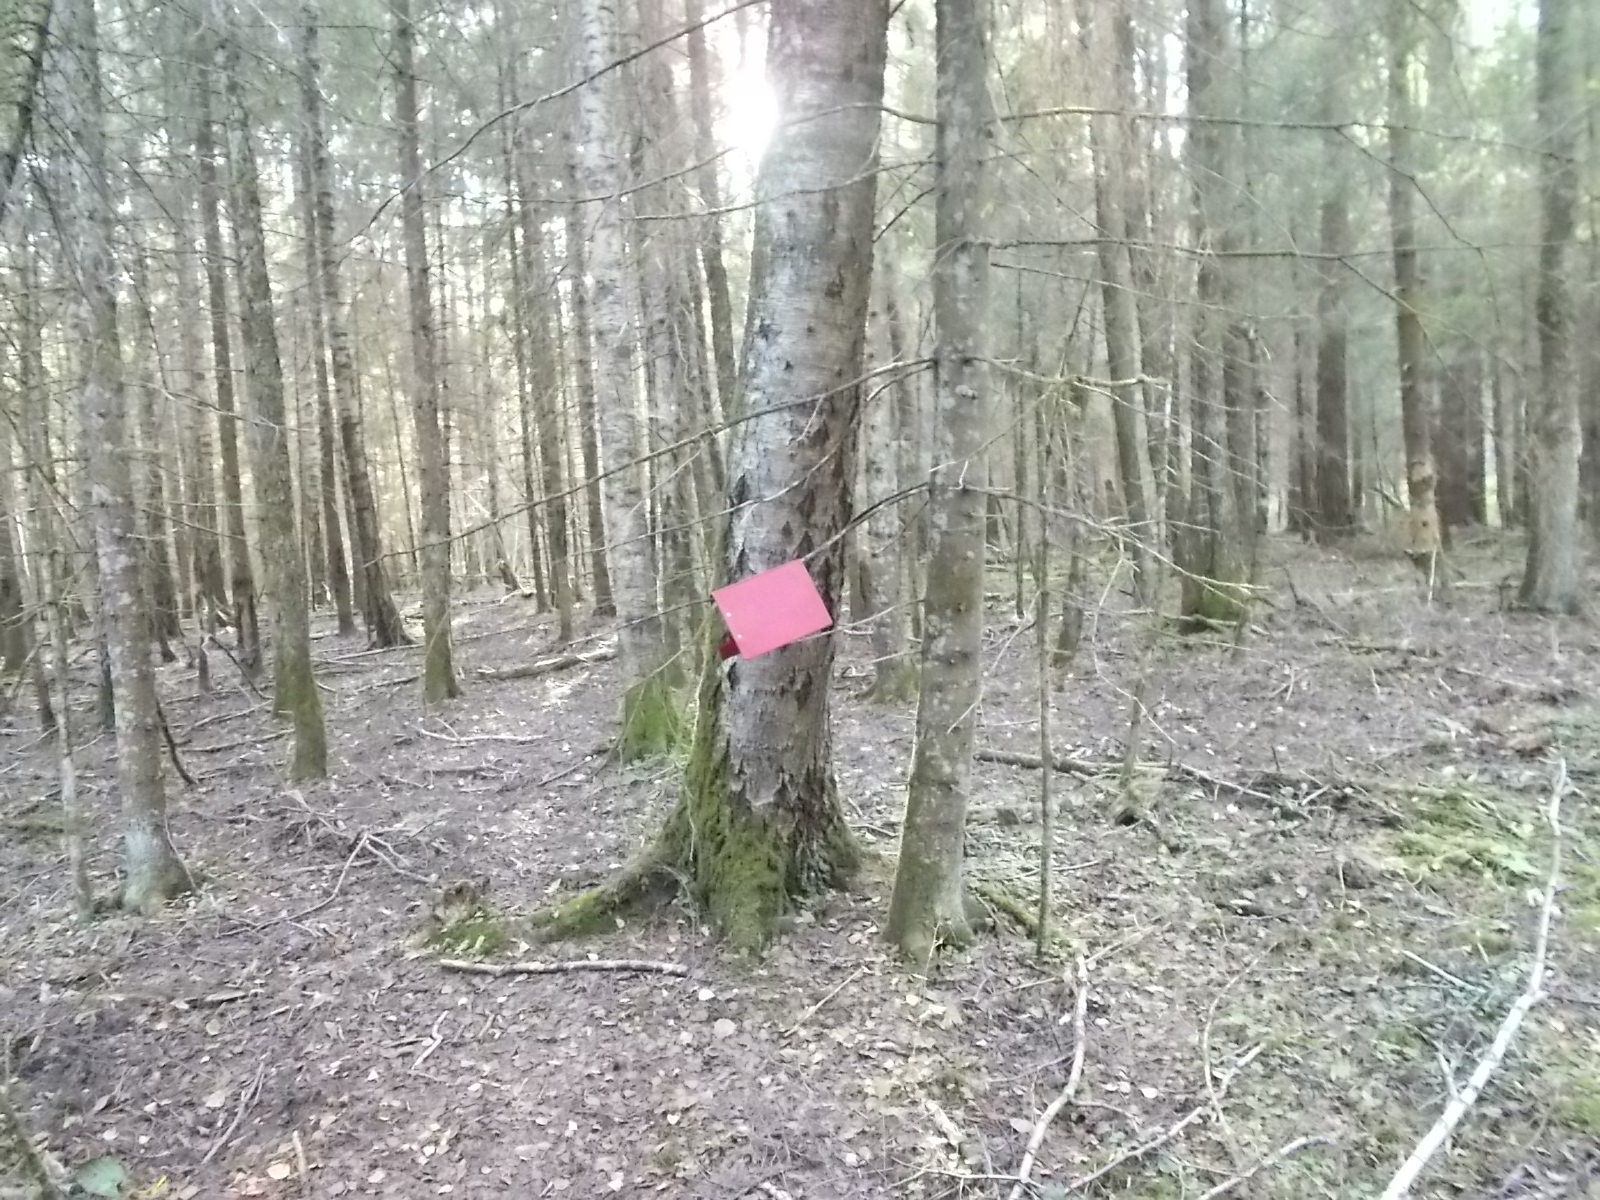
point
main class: Woodland
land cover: Spruce dominated mixed woodland
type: hemiboreal forest and nemoral coniferous forest and mixed broadleaved-coniferous forest
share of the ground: 50 - 75 %
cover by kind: coniferous forest trees 35 %, broadleaved forest trees 35 %, herbaceous plants 15 %, unconsolidated bare surface 10 %, shrubs 5 %
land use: Forestry
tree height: > 5 m
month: September
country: LV
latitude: 57.1311
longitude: 21.8235
